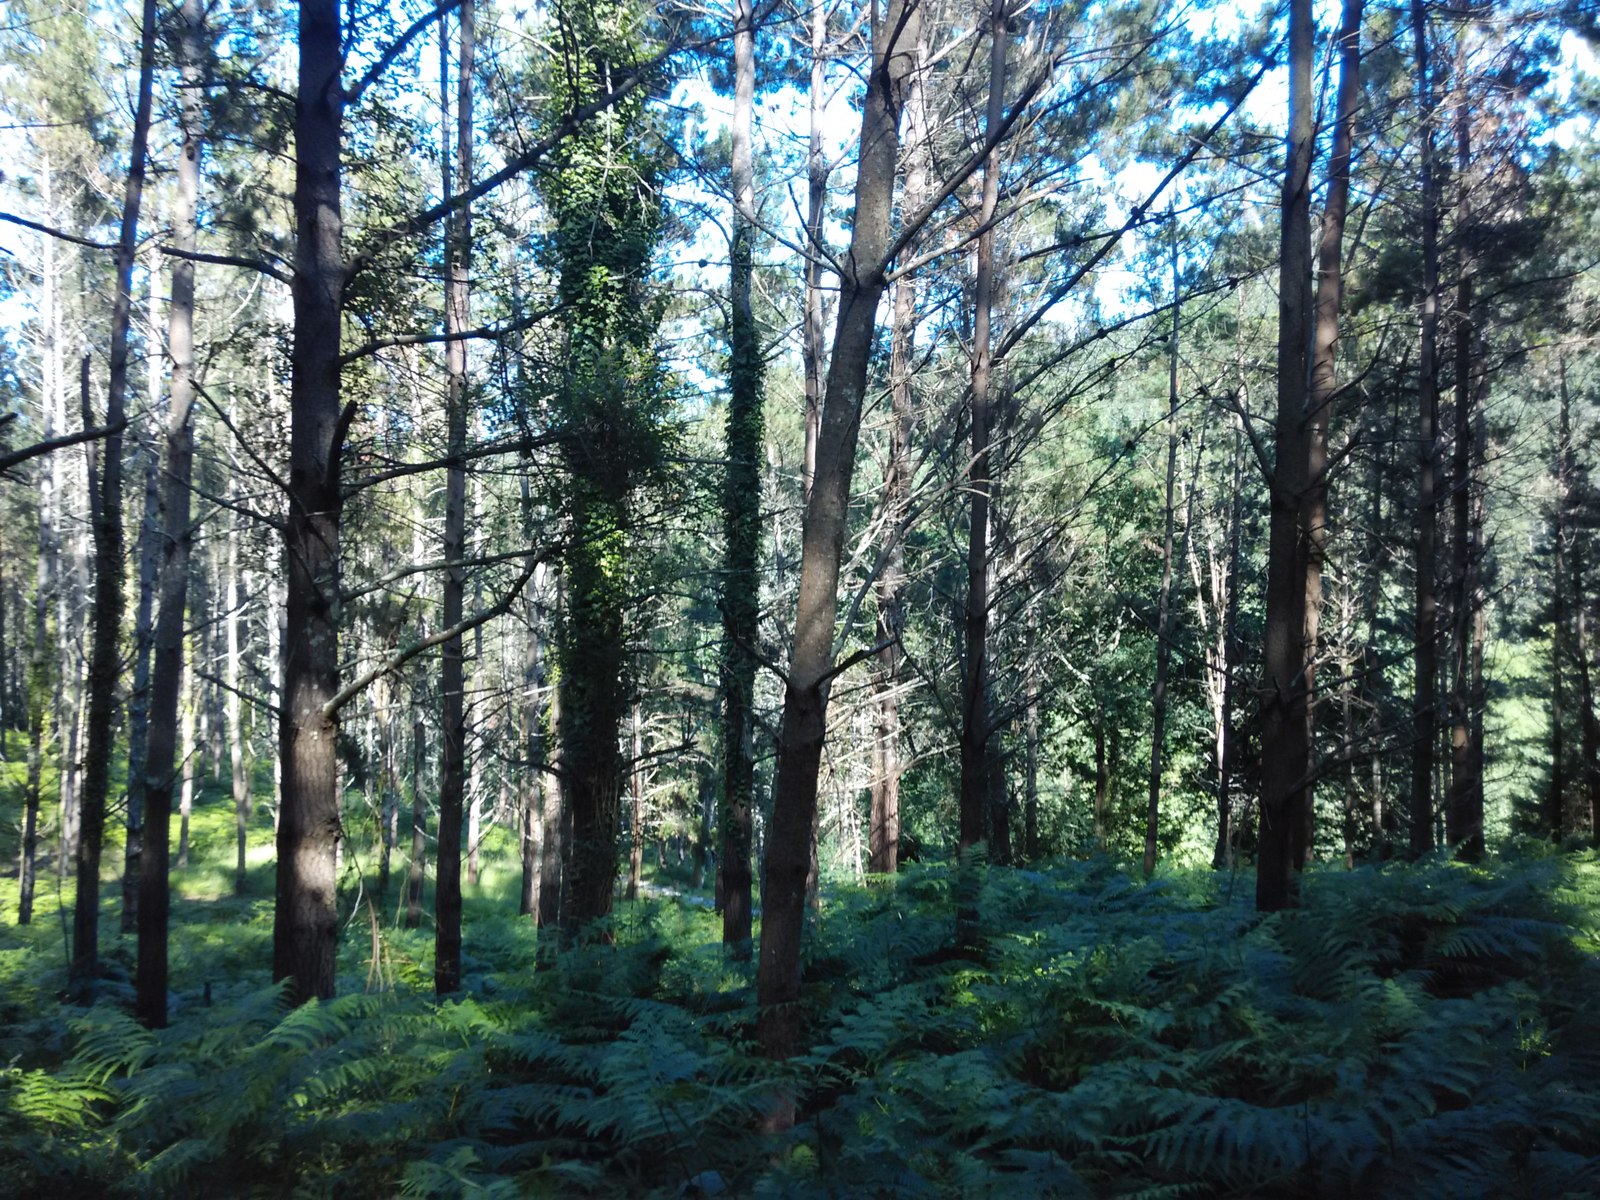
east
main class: Woodland
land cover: Pine dominated coniferous woodland
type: exotic forest
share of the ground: > 75 %
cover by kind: coniferous forest trees 100 %
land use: Forestry
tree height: > 5 m
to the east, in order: Pine dominated coniferous woodland; Paved roads, cycling and walking lanes; Pine dominated coniferous woodland; Electric lines; Pine dominated coniferous woodland; Paved roads, cycling and walking lanes; Pine dominated coniferous woodland; Broadleaved woodland; Rivers and streams; Broadleaved woodland
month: June
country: ES
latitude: 43.3333
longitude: -2.5232
